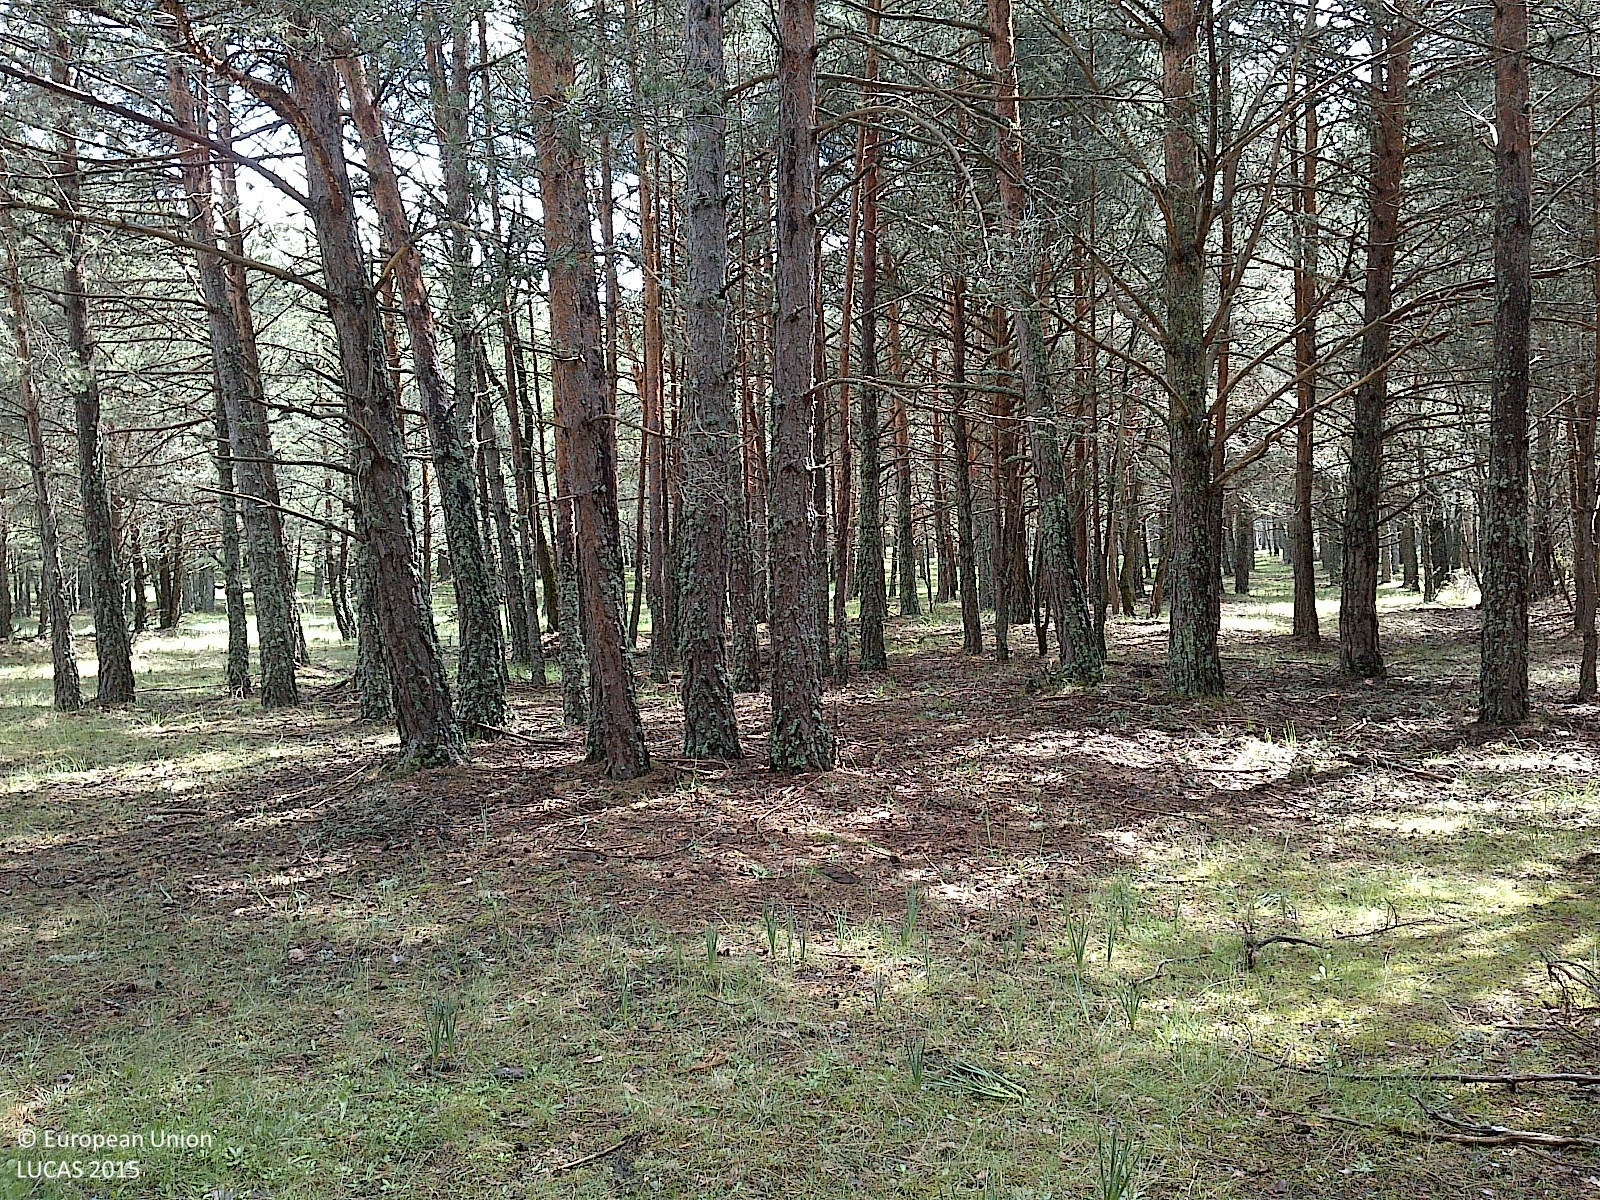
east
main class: Woodland
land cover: Pine dominated coniferous woodland
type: coniferous forest of the mediterranean region
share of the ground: > 75 %
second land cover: Grassland without tree/shrub cover
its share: 50 - 75 %
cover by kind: coniferous forest trees 85 %, herbaceous plants 15 %
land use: Forestry
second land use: Agriculture (excluding fallow land and kitchen gardens)
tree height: > 5 m
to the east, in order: Pine dominated coniferous woodland; Grassland without tree/shrub cover
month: April
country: ES
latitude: 41.8180
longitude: -2.8156
